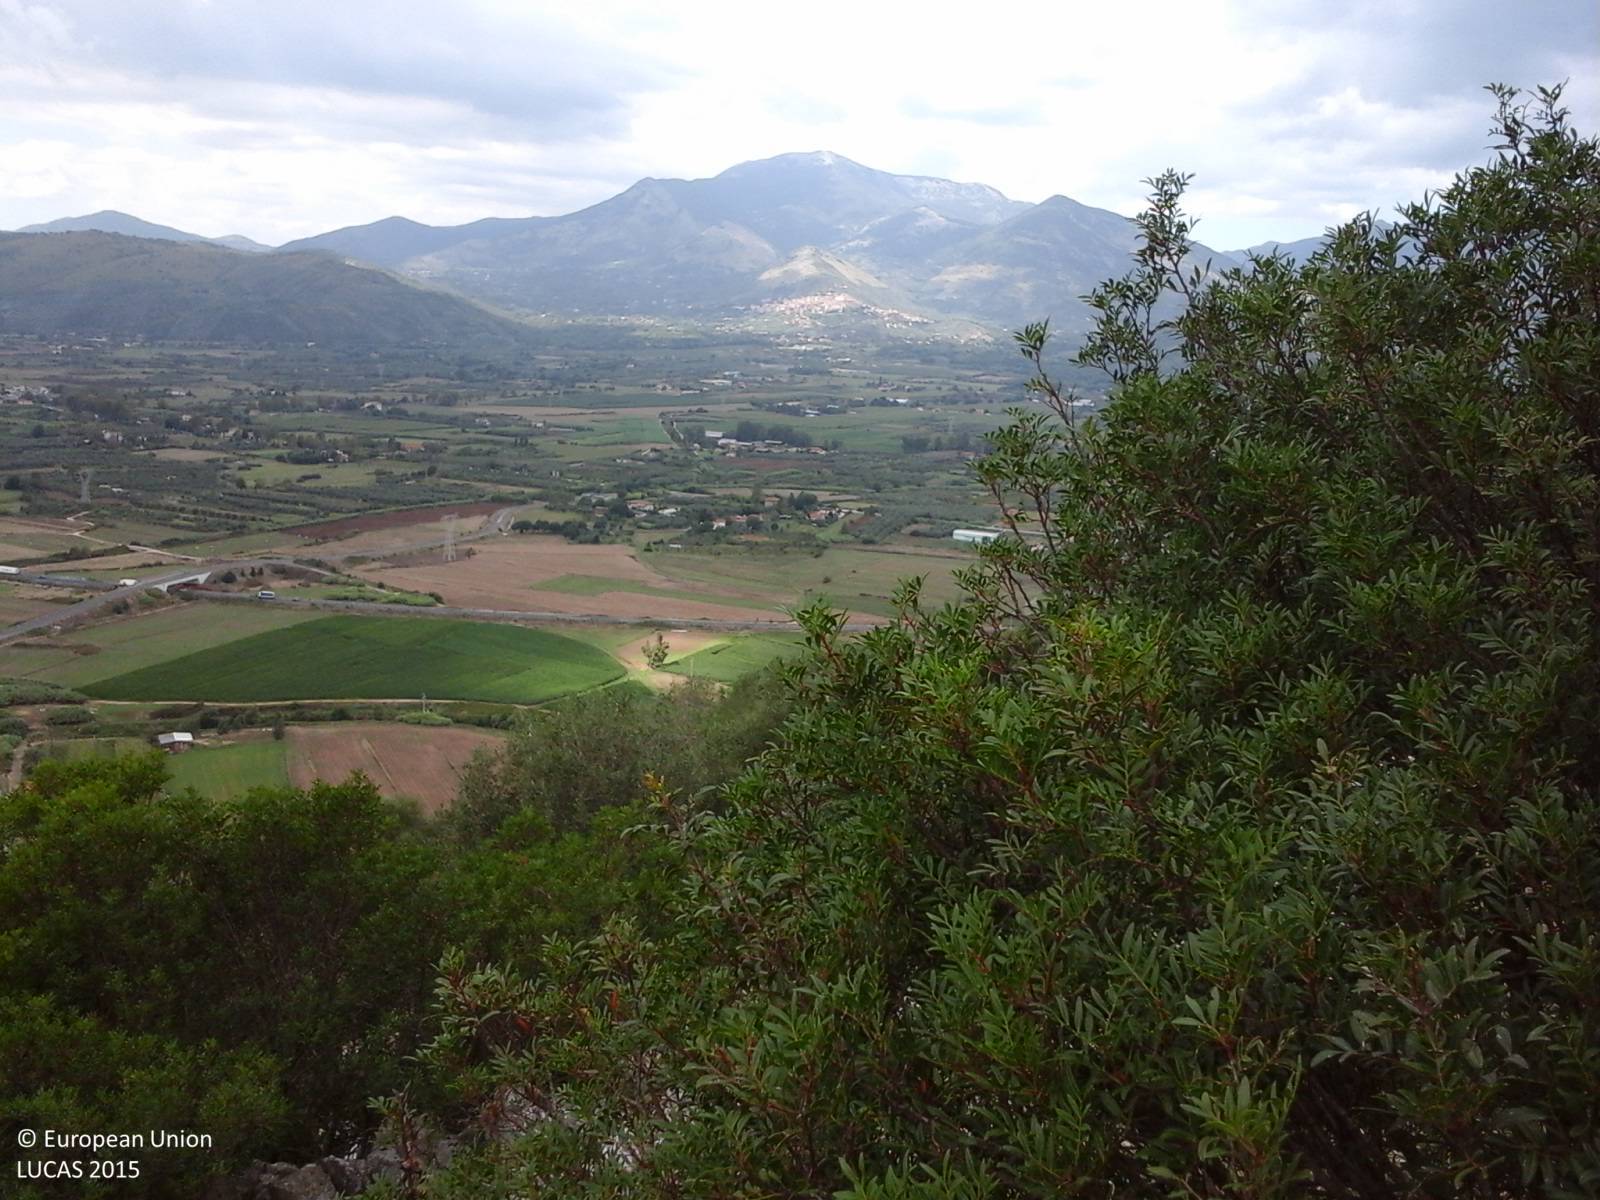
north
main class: Cropland
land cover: Olive groves
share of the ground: 25 - 50 %
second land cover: Grassland without tree/shrub cover
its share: 25 - 50 %
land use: Abandoned areas
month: August
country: IT
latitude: 41.4821
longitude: 13.2090
